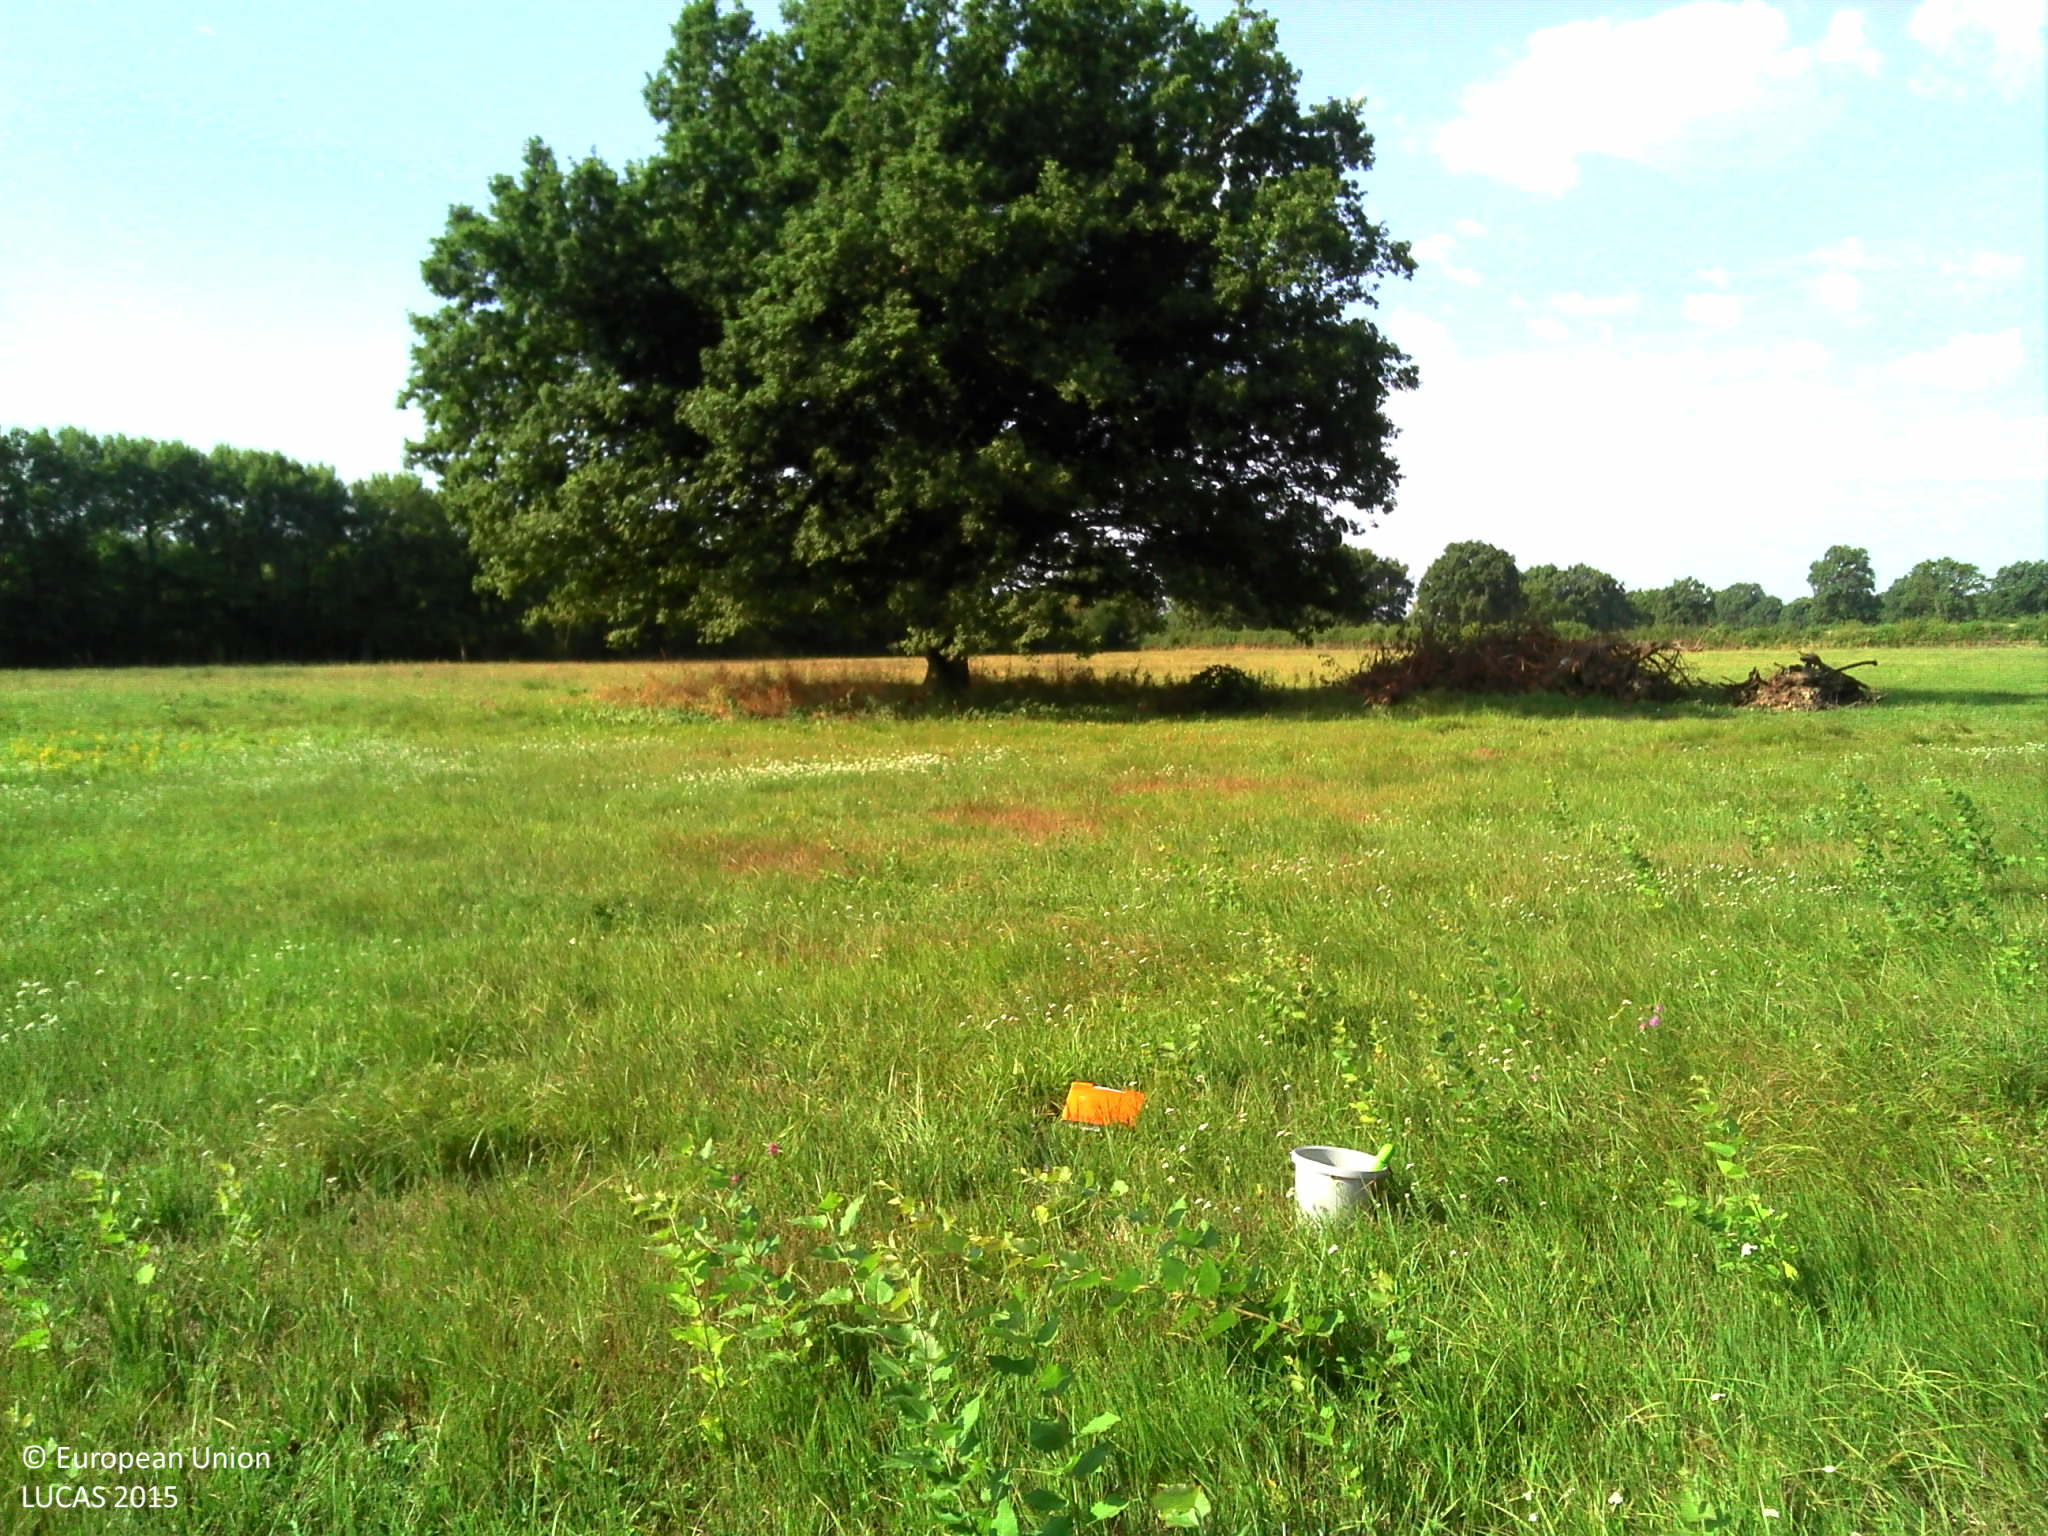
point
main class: Grassland
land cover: Grassland without tree/shrub cover
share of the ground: > 75 %
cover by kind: herbaceous plants 100 %
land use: Agriculture (excluding fallow land and kitchen gardens)
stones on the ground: < 10 %
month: August
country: FR
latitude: 46.7060
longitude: 2.8150
